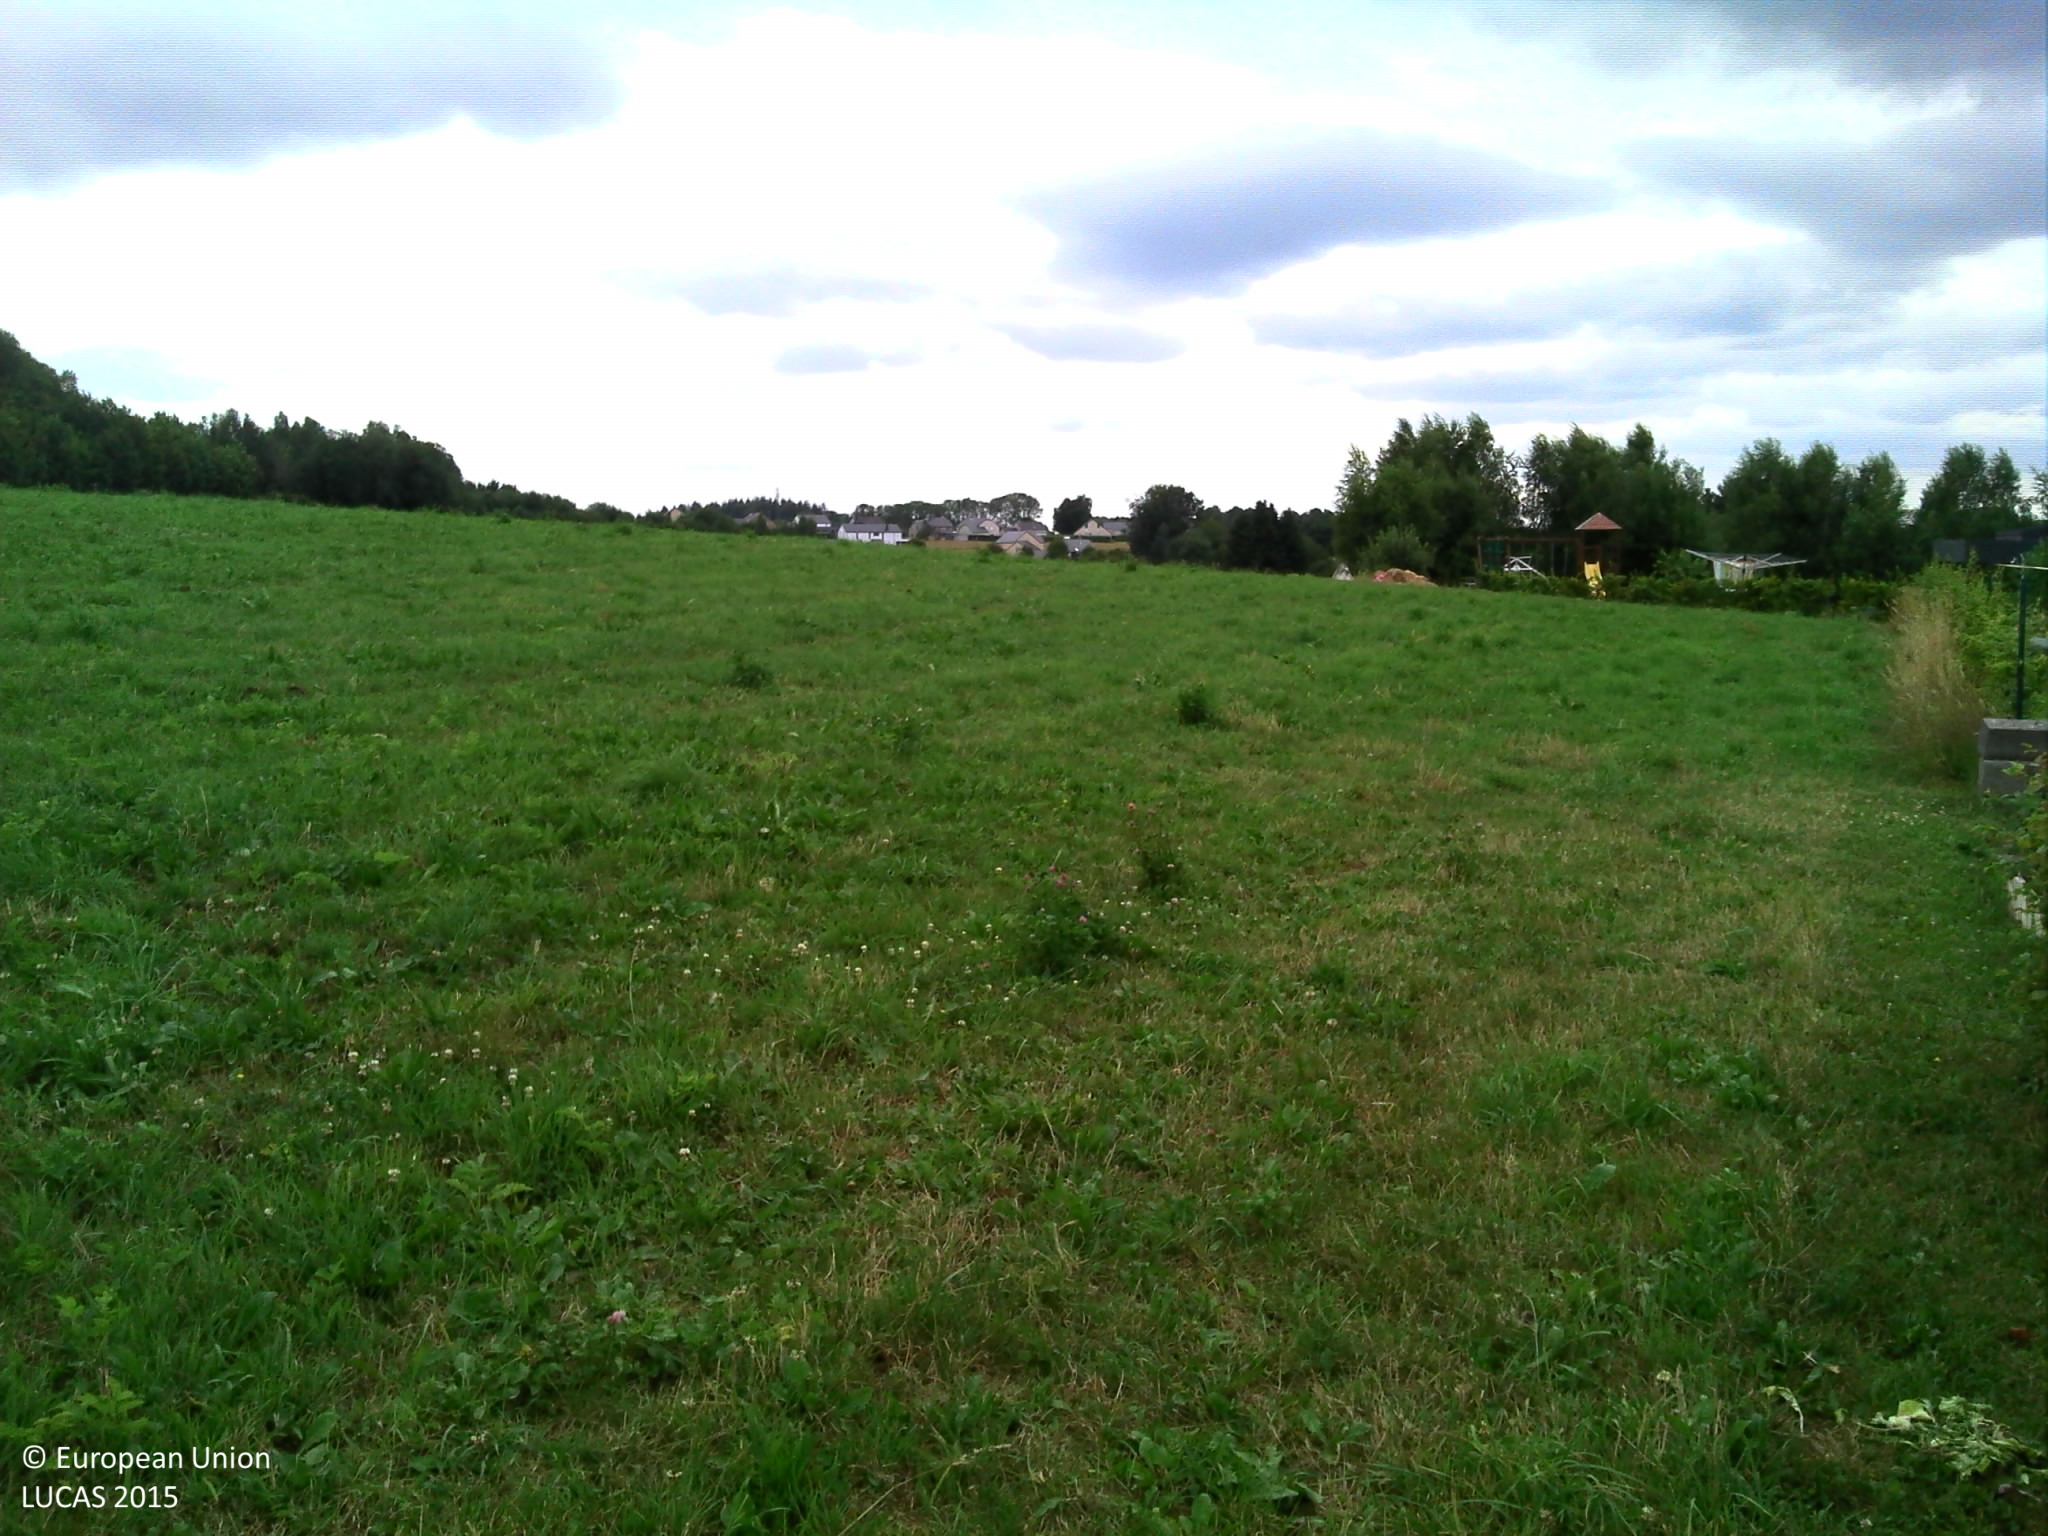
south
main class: Grassland
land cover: Grassland without tree/shrub cover
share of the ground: > 75 %
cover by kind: herbaceous plants 100 %
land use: Residential
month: July
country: BE
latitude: 49.7761
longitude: 5.6244
